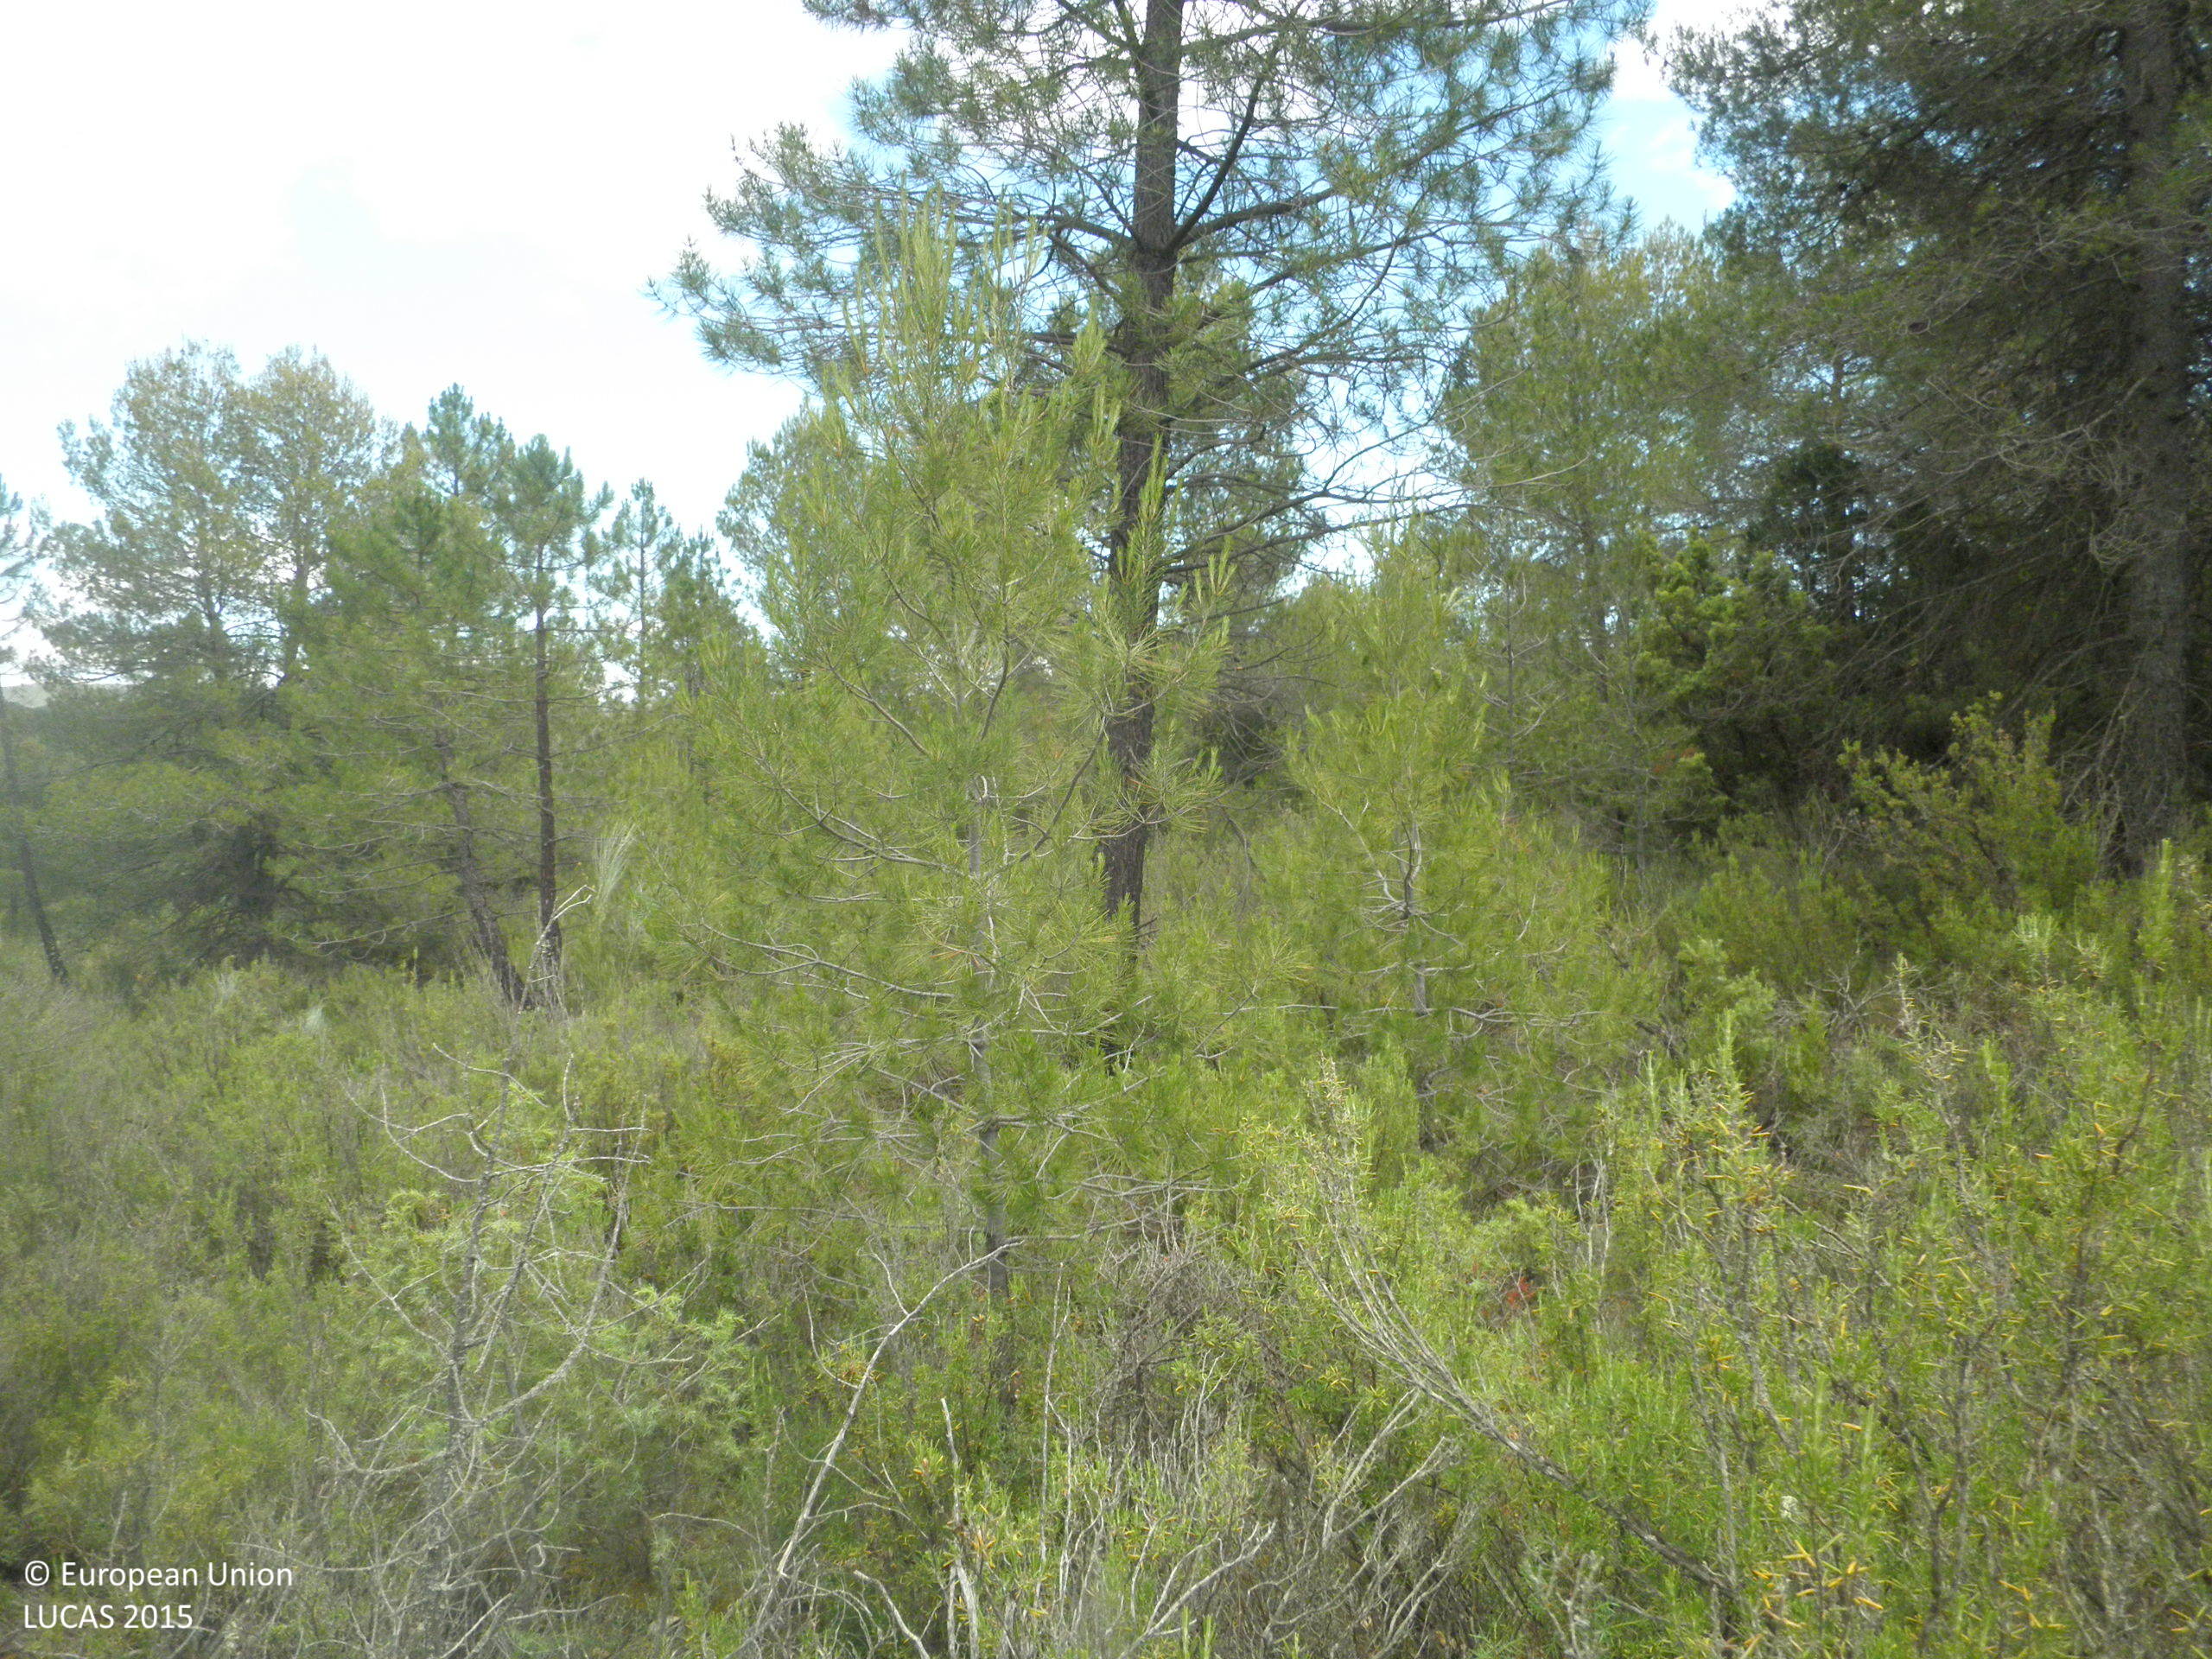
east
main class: Woodland
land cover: Pine dominated coniferous woodland
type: coniferous forest of the mediterranean region
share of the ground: 10 - 25 %
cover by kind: shrubs 75 %, coniferous forest trees 15 %, unconsolidated bare surface 10 %
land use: Semi-natural and natural areas not in use
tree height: > 5 m
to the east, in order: Pine dominated coniferous woodland
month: June
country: ES
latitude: 39.7390
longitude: -1.6183
